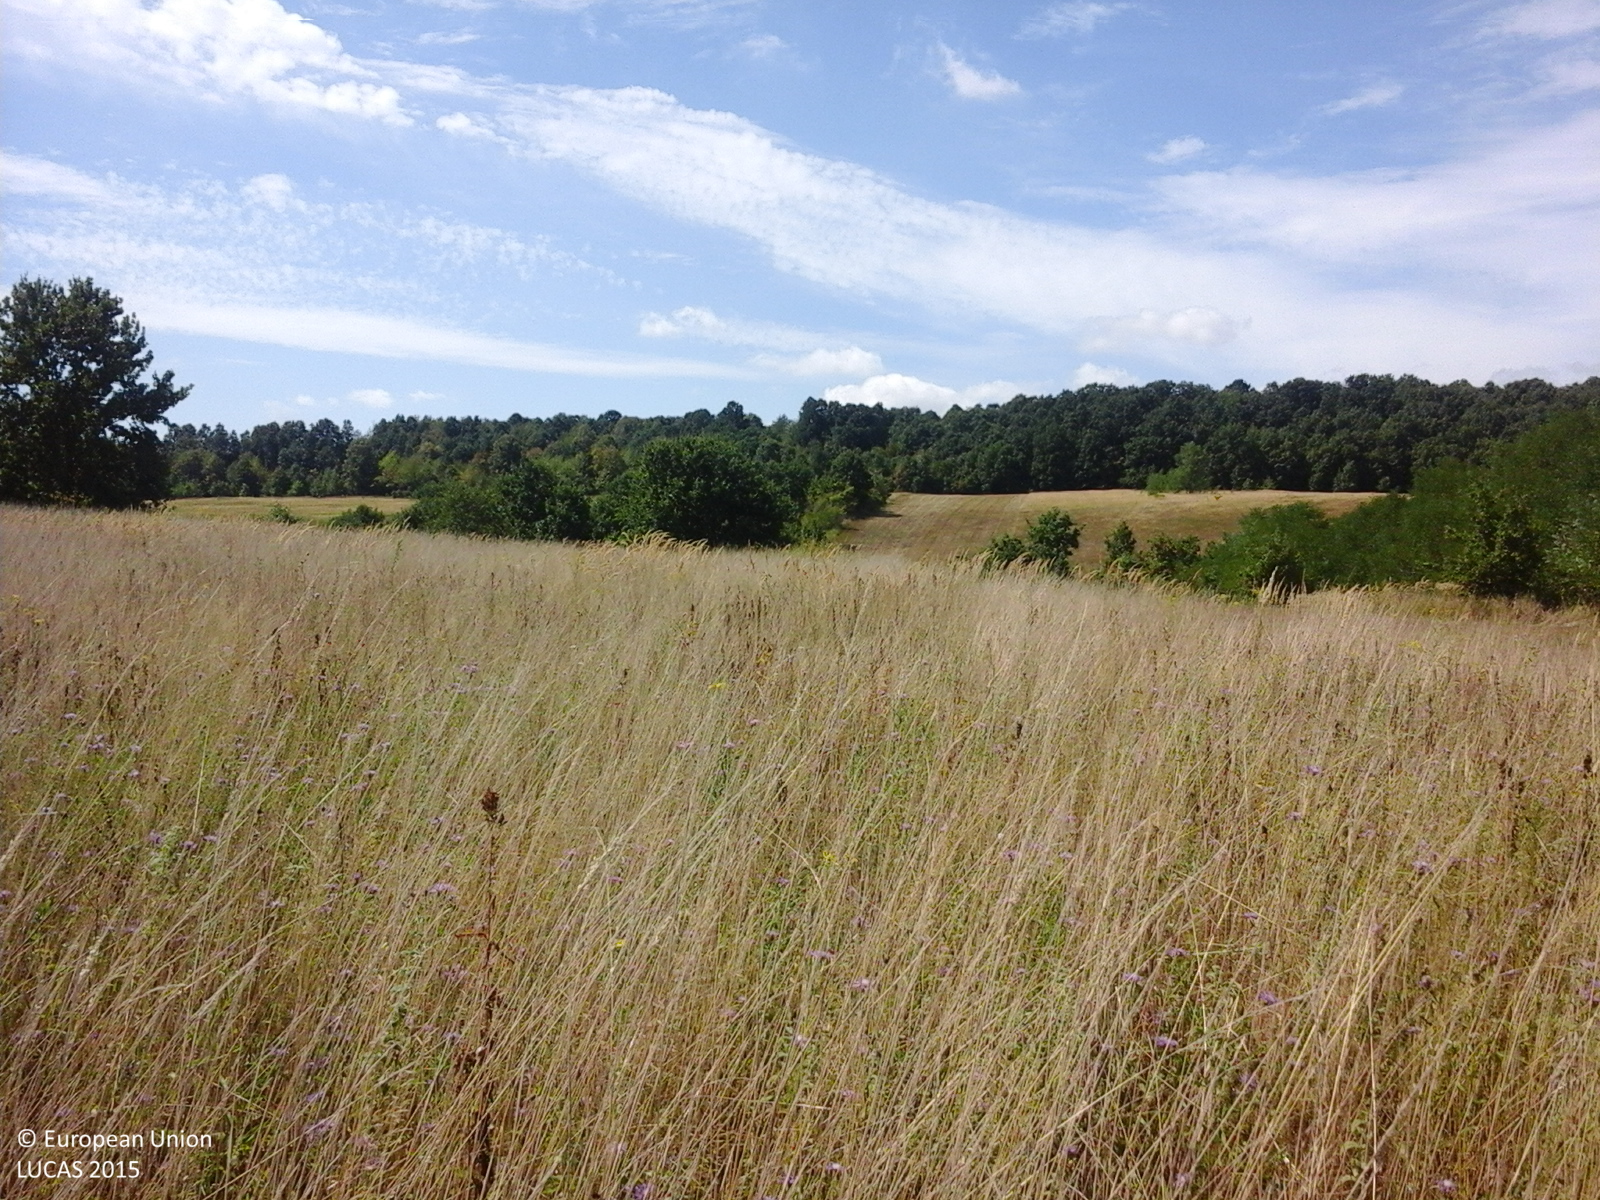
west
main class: Grassland
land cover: Spontaneously vegetated surfaces
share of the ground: > 75 %
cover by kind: herbaceous plants 100 %
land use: Agriculture (excluding fallow land and kitchen gardens)
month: August
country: RO
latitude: 45.3472
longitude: 21.6605
